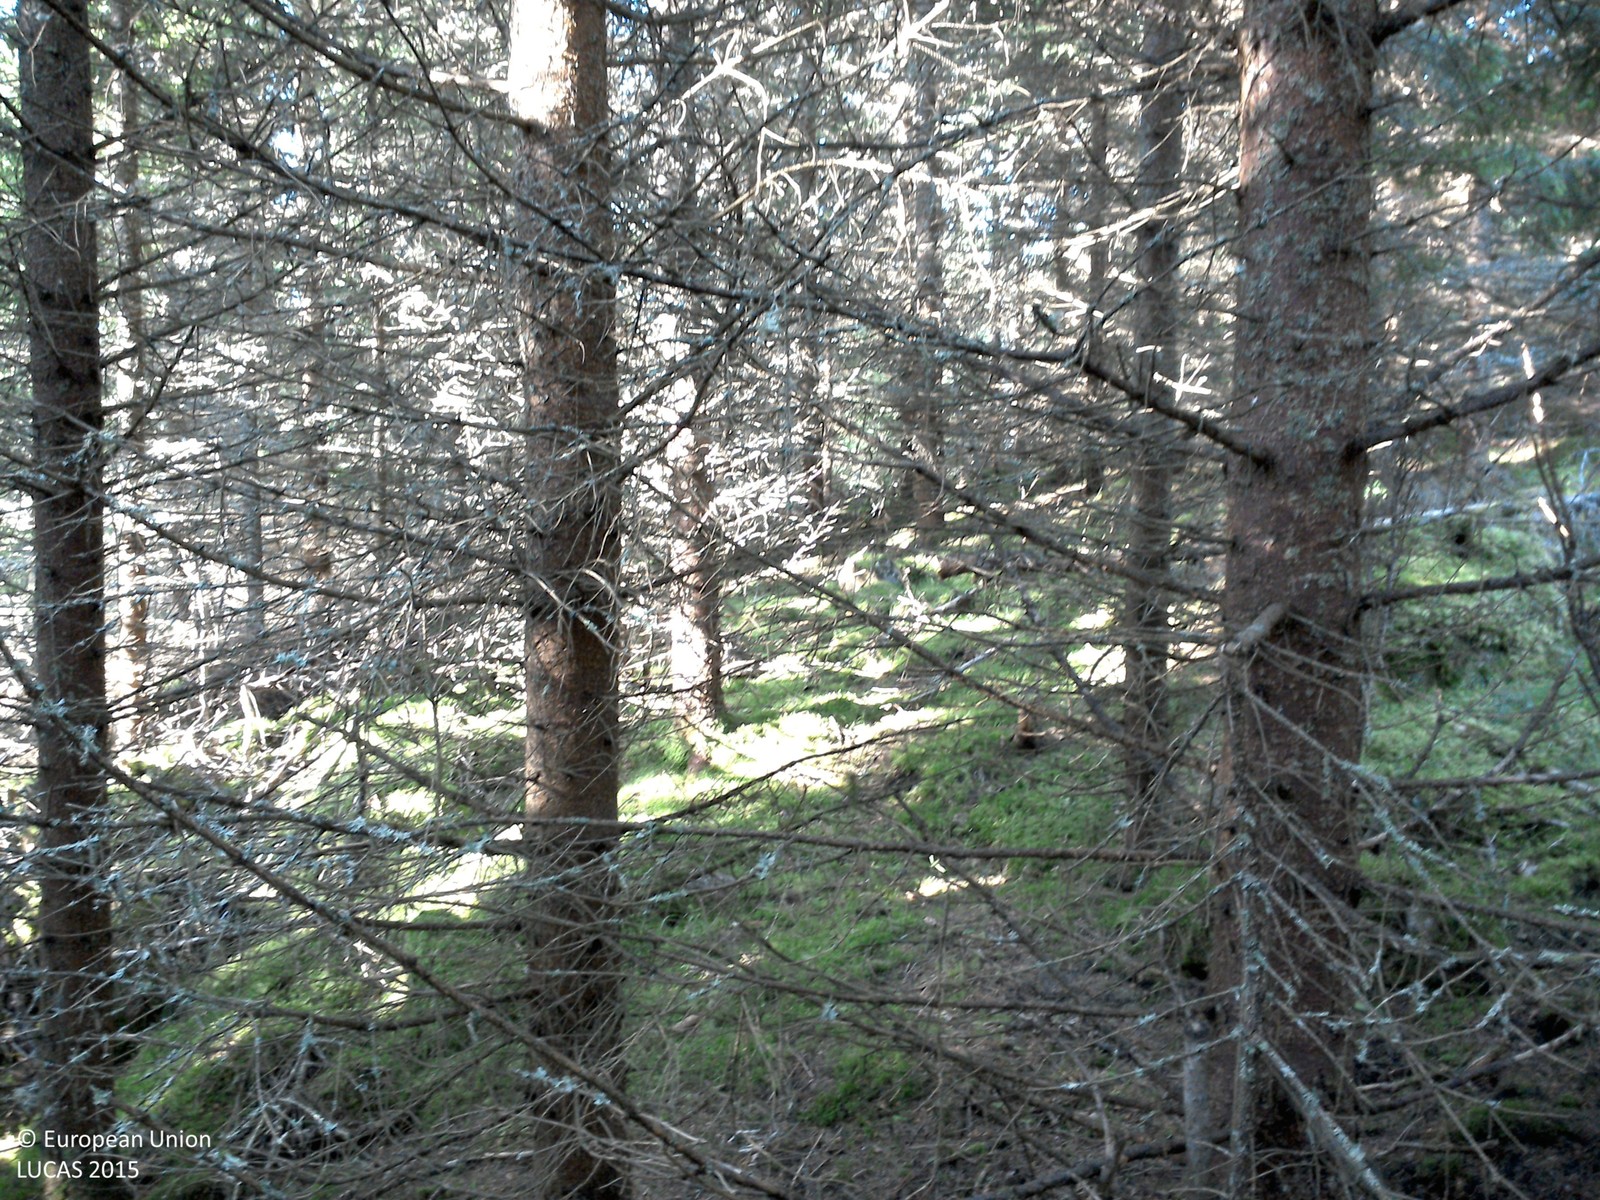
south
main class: Woodland
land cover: Spruce dominated coniferous woodland
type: boreal forest
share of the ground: > 75 %
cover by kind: coniferous forest trees 80 %, lichens and mosses 20 %
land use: Forestry
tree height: > 5 m
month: August
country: SE
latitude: 58.1289
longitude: 14.9359
